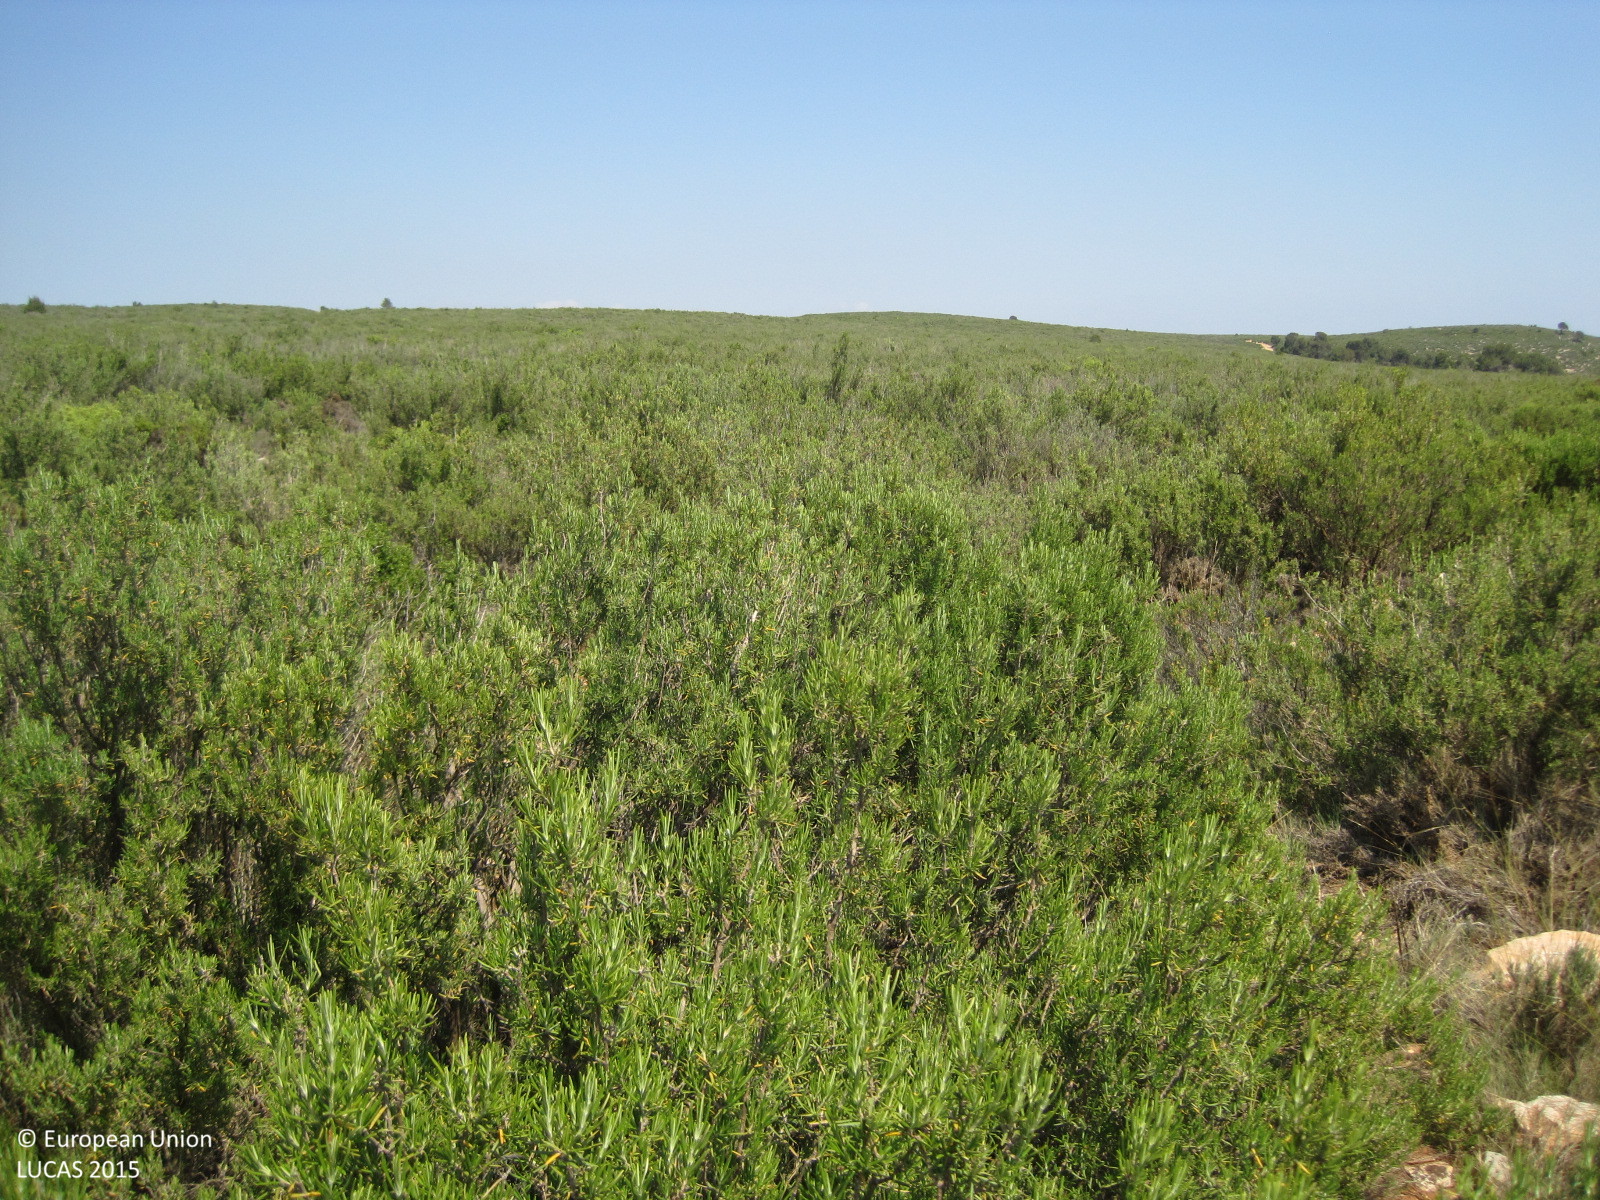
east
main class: Shrubland
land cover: Shrubland without tree cover
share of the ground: > 75 %
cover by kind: shrubs 85 %, consolidated bare surface 10 %, herbaceous plants 5 %
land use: Semi-natural and natural areas not in use
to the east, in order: Shrubland without tree cover; Tracks; Shrubland without tree cover
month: June
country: ES
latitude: 39.2437
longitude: -0.8537
